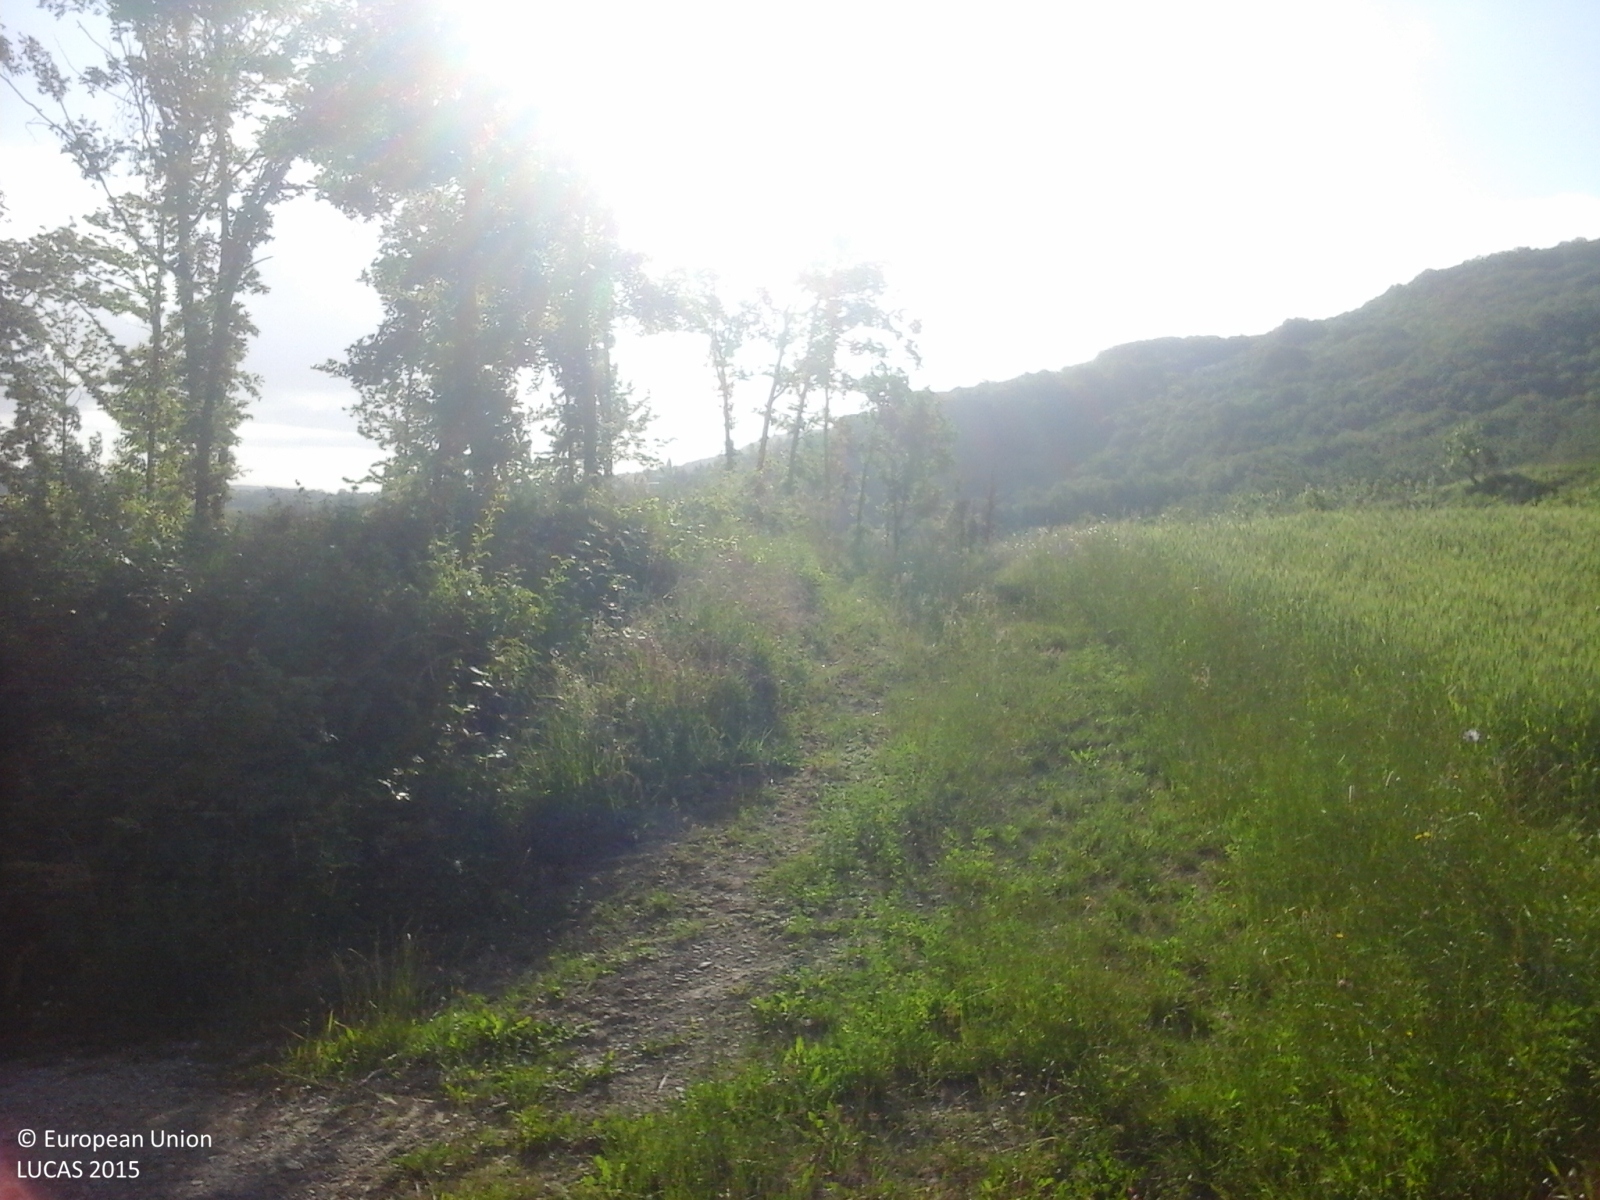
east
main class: Cropland
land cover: Common wheat
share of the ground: > 75 %
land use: Agriculture (excluding fallow land and kitchen gardens)
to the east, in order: Common wheat; Nuts trees; Grassland with sparse tree/shrub cover; Tracks; Nuts trees; Shrubland with sparse tree cover; Grassland without tree/shrub cover; Shrubland with sparse tree cover; Broadleaved woodland; Inland fresh water bodies; Lines of trees; Grassland without tree/shrub cover; Tracks; Common wheat
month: May
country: IT
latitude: 44.3273
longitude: 11.0384
